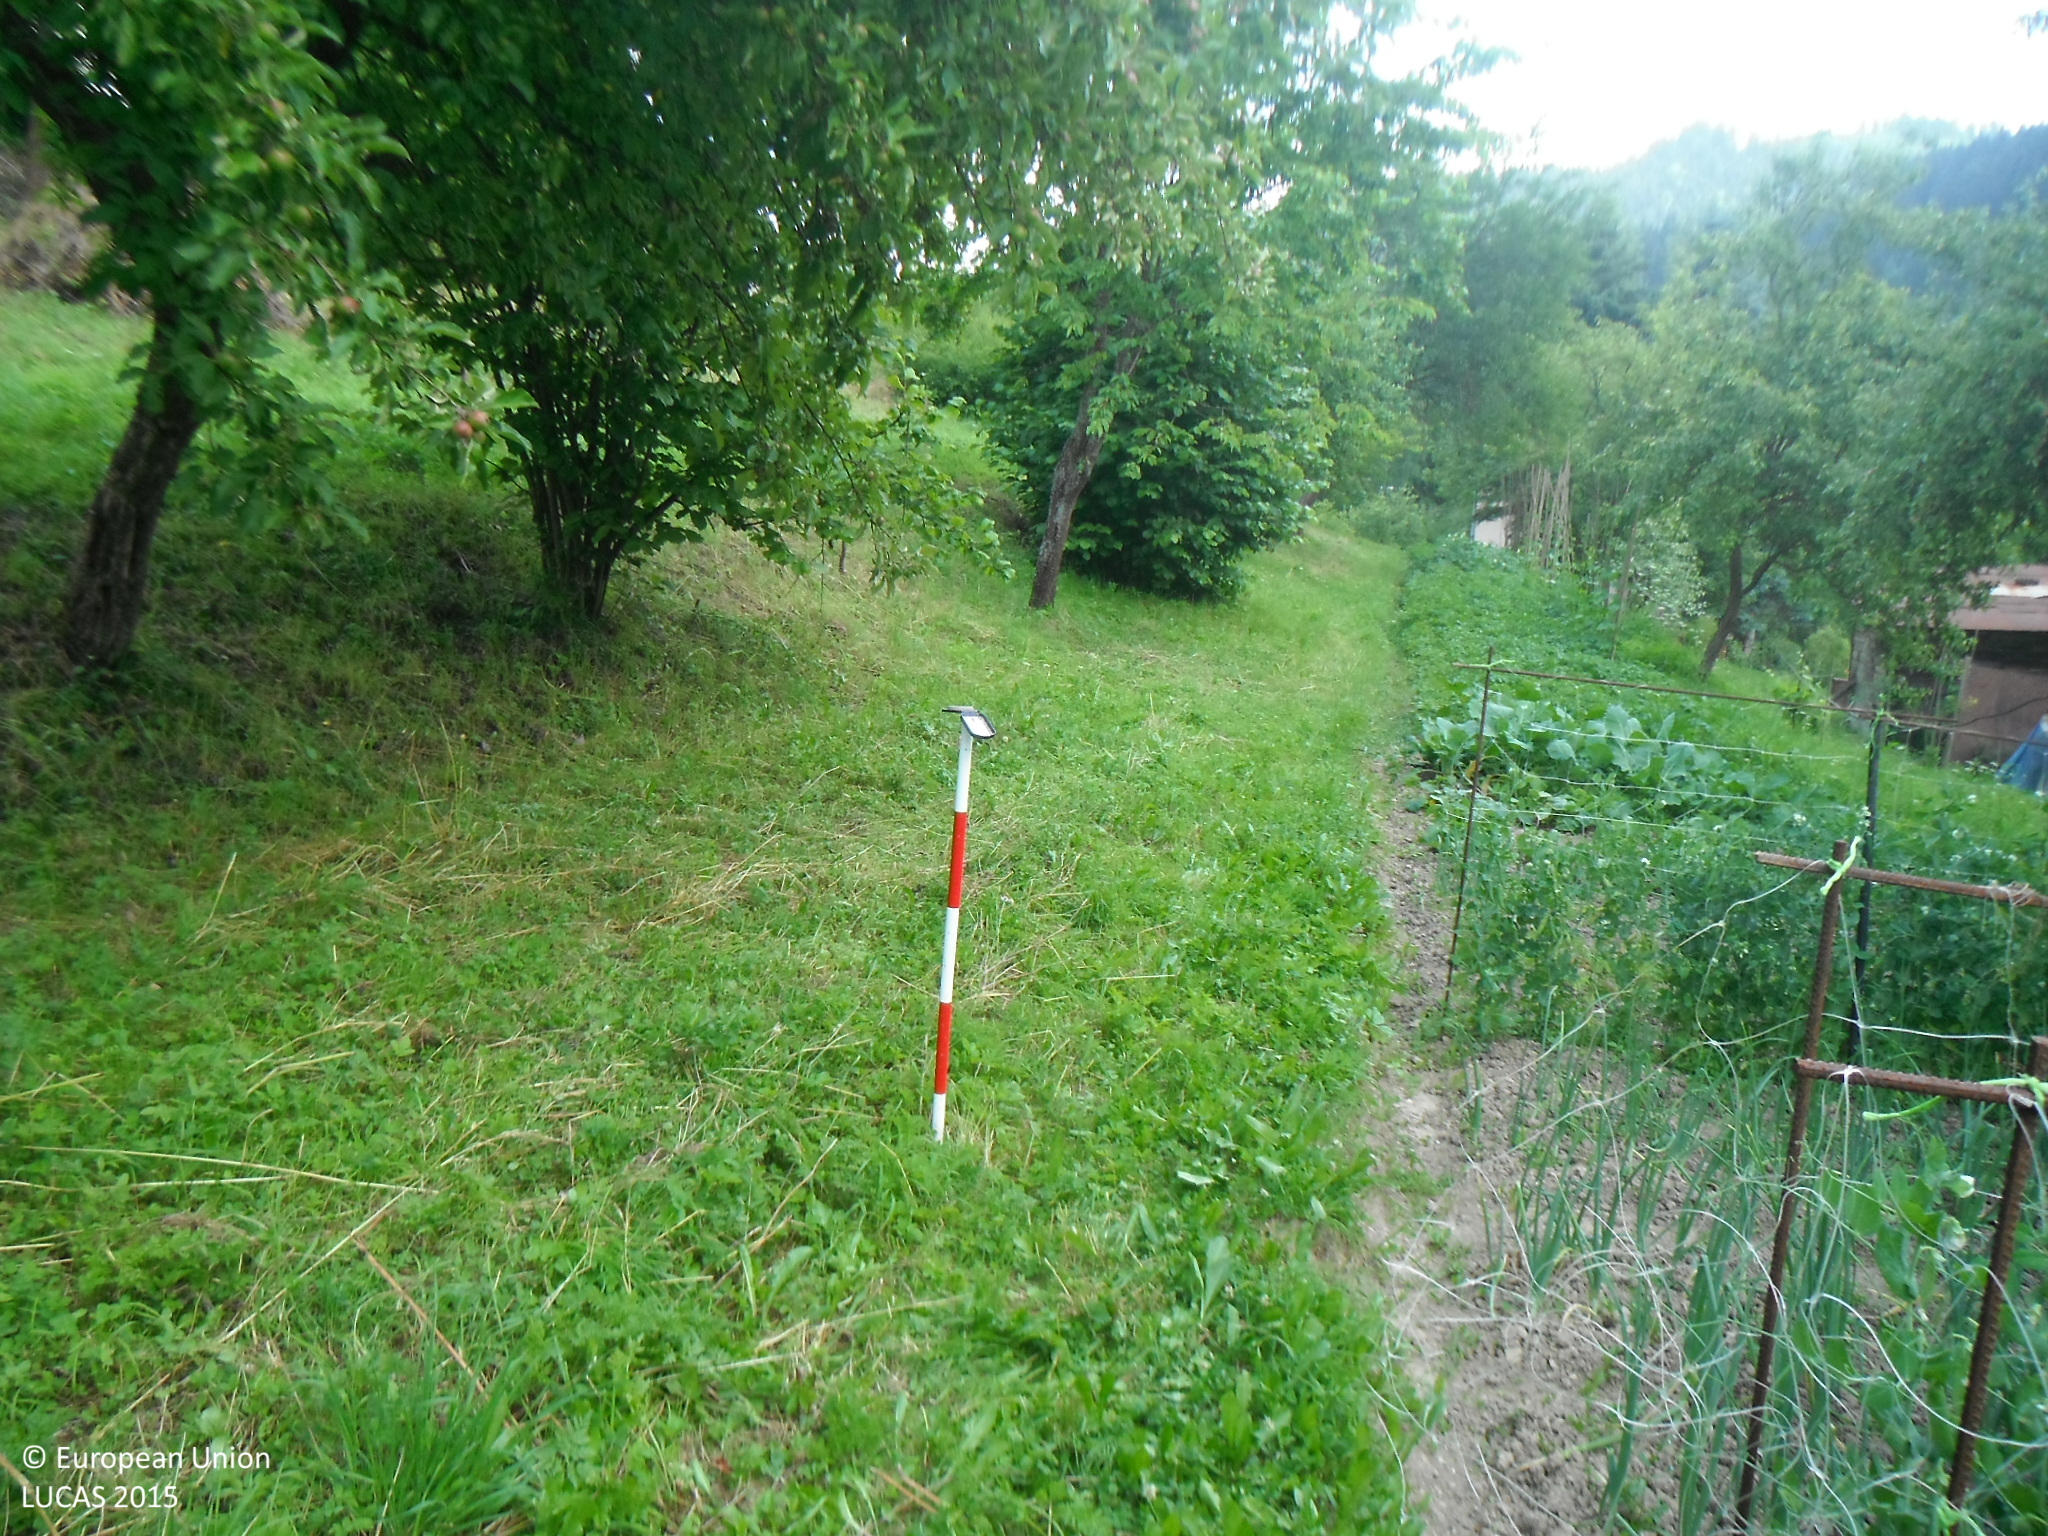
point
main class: Cropland
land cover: Apple fruit
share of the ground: 25 - 50 %
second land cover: Grassland without tree/shrub cover
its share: > 75 %
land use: Kitchen garden
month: July
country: SK
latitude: 49.2814
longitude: 18.5830
